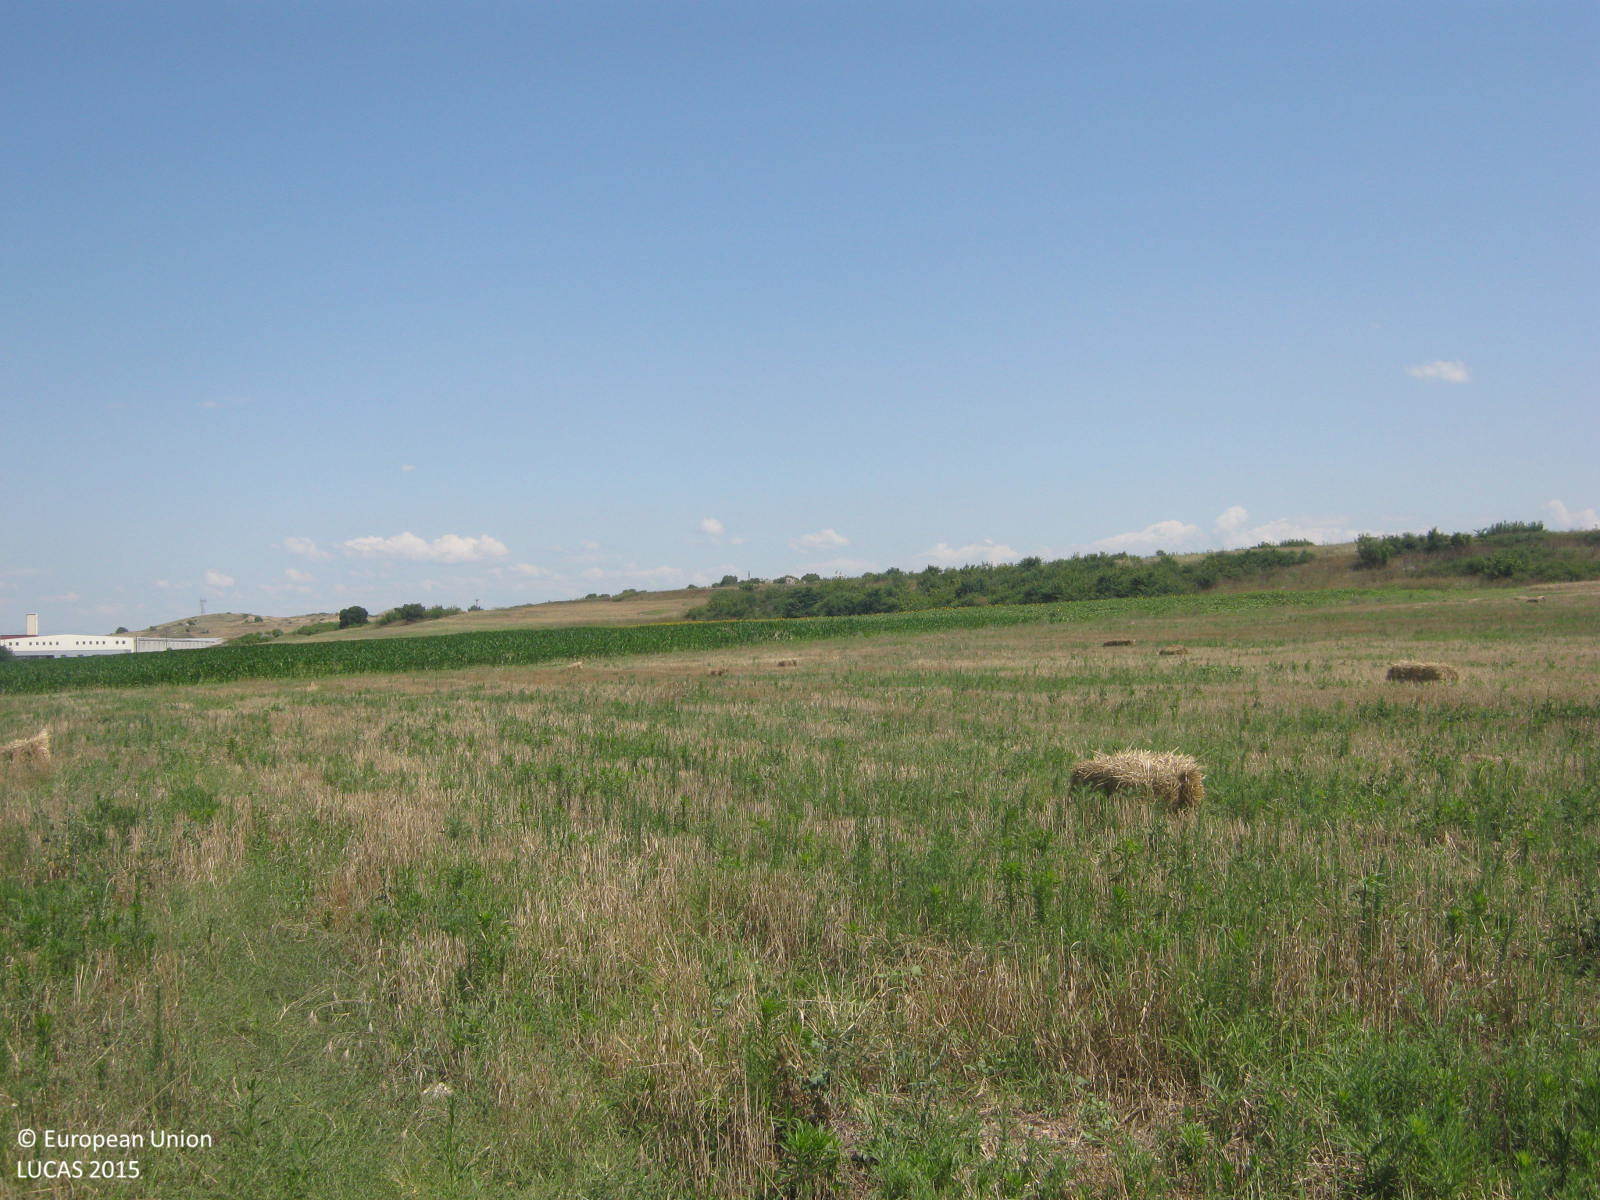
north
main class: Cropland
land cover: Common wheat
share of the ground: > 75 %
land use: Agriculture (excluding fallow land and kitchen gardens)
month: July
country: GR
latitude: 40.9609
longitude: 22.6614
